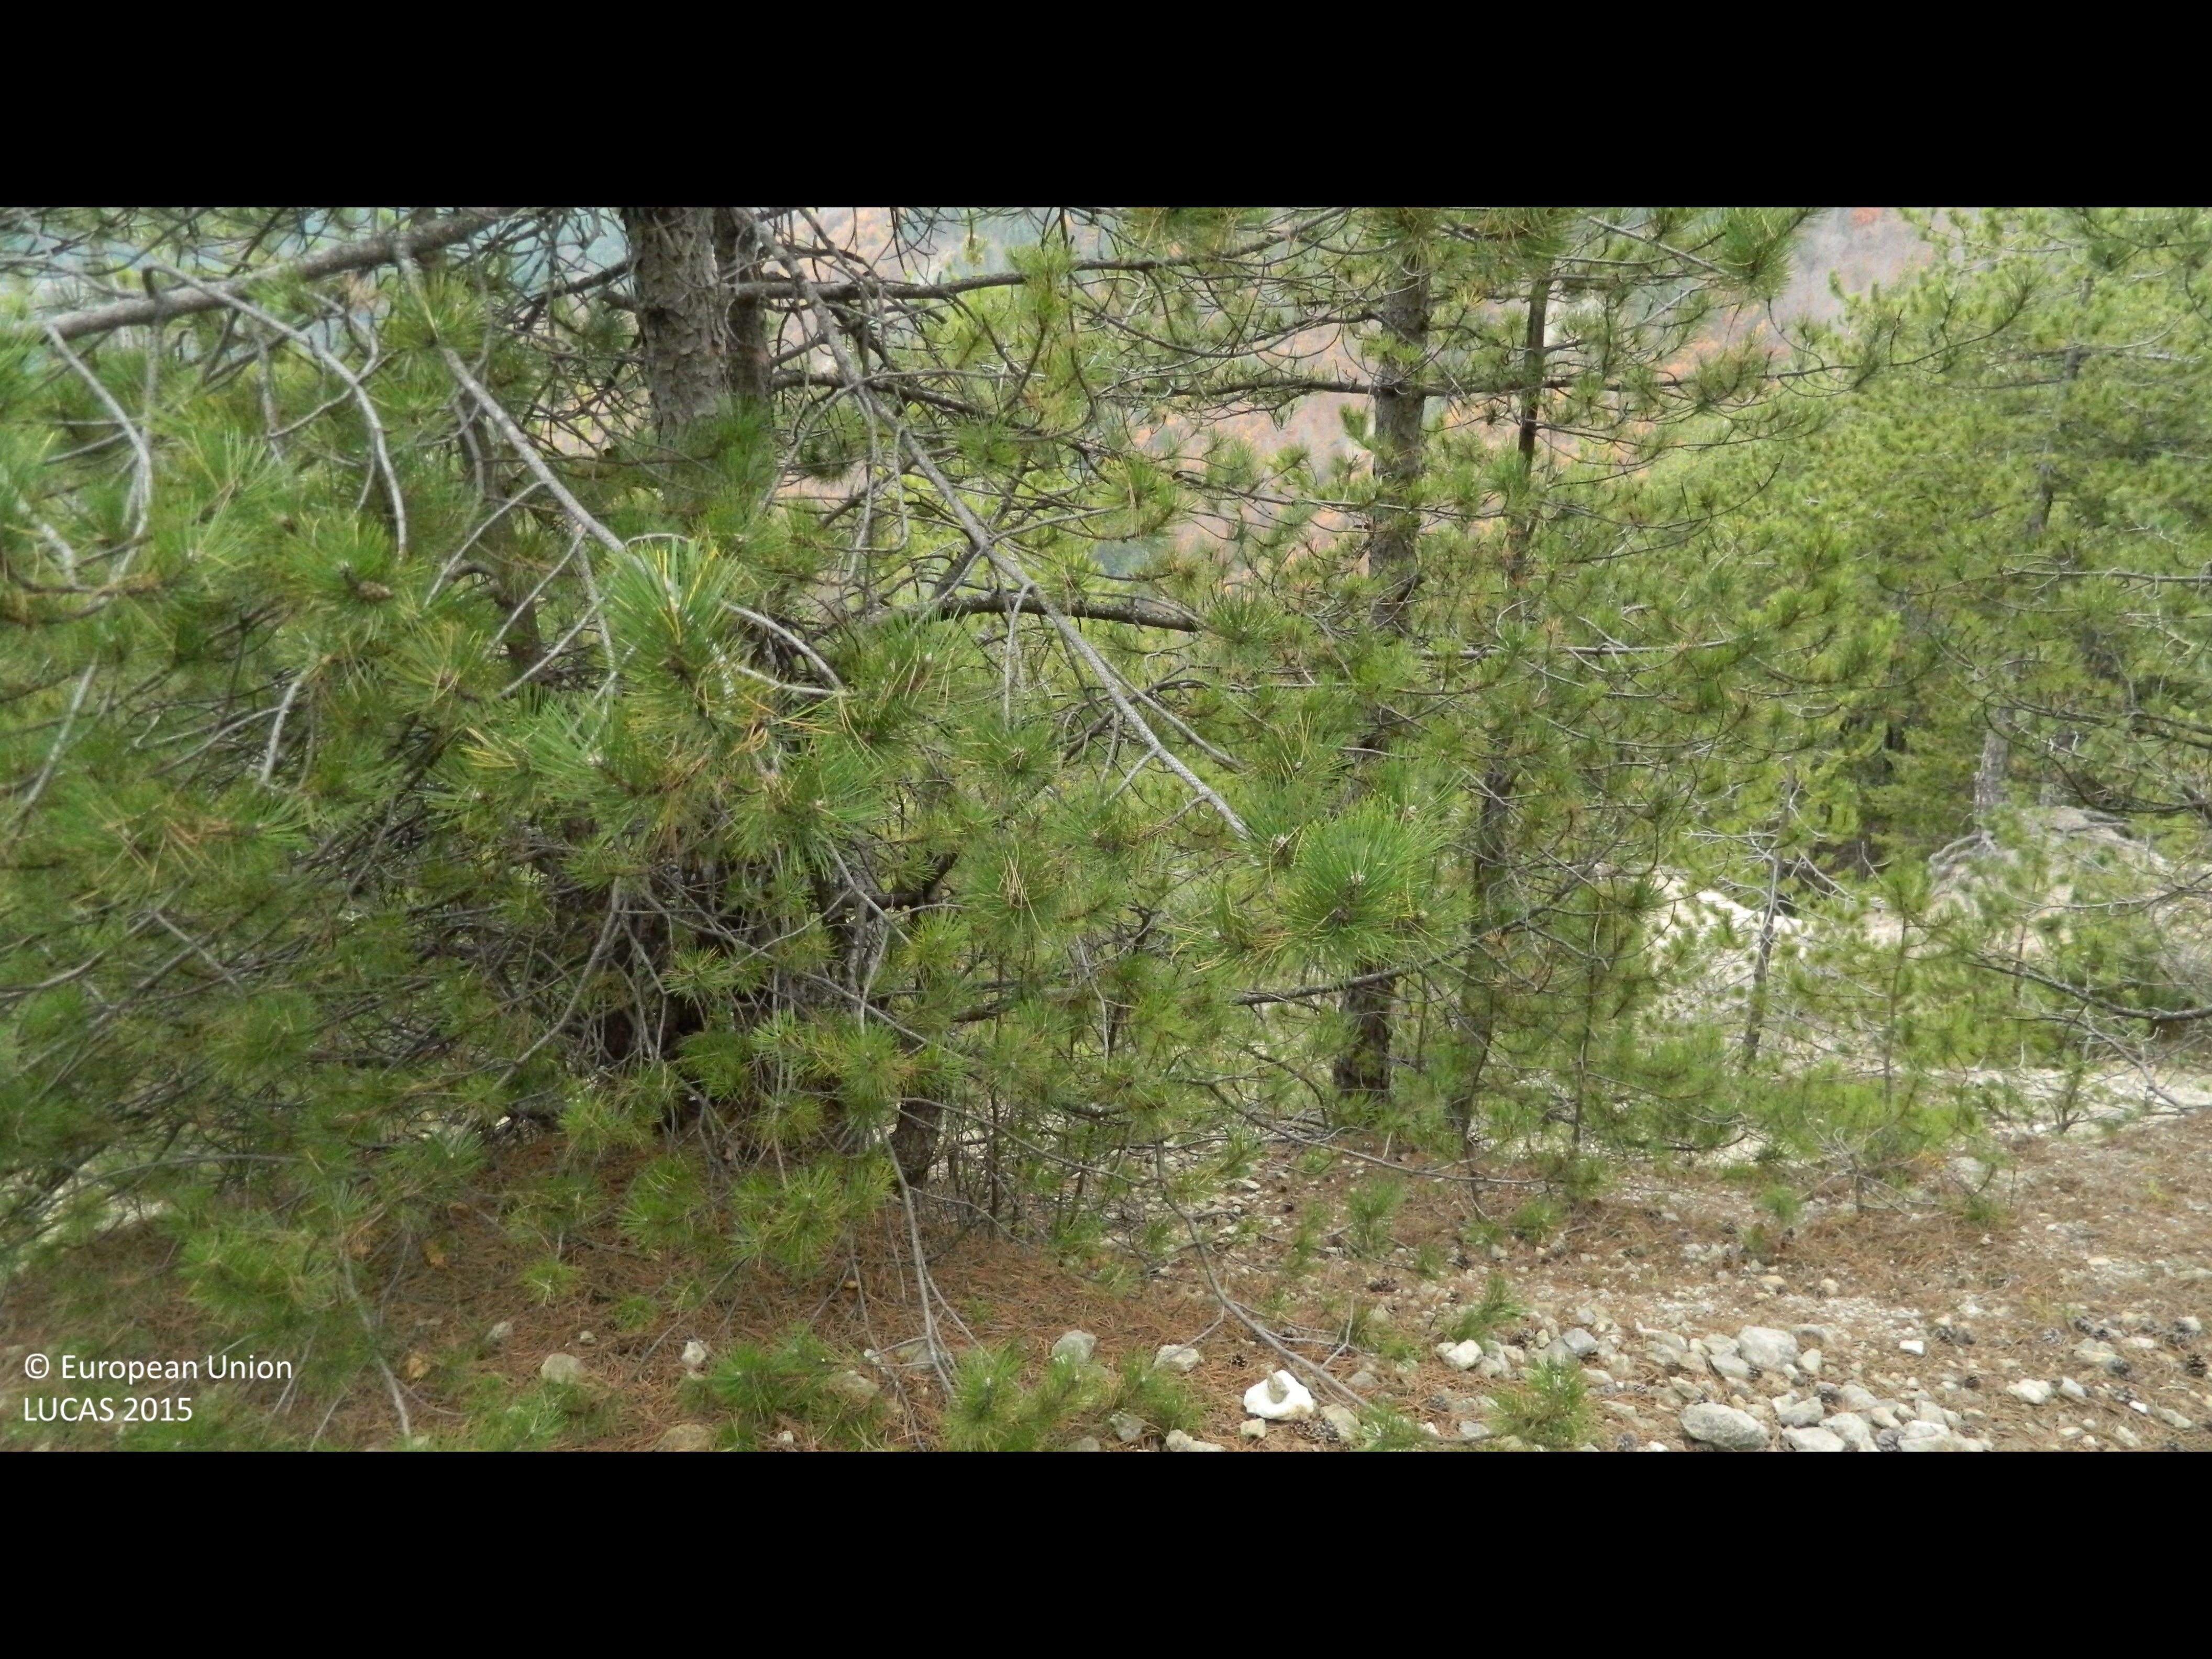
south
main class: Woodland
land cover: Pine dominated coniferous woodland
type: alpine coniferous forest
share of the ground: 50 - 75 %
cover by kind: coniferous forest trees 70 %, unconsolidated bare surface 30 %
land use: Forestry
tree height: > 5 m
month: November
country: BG
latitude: 41.8346
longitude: 25.0450
